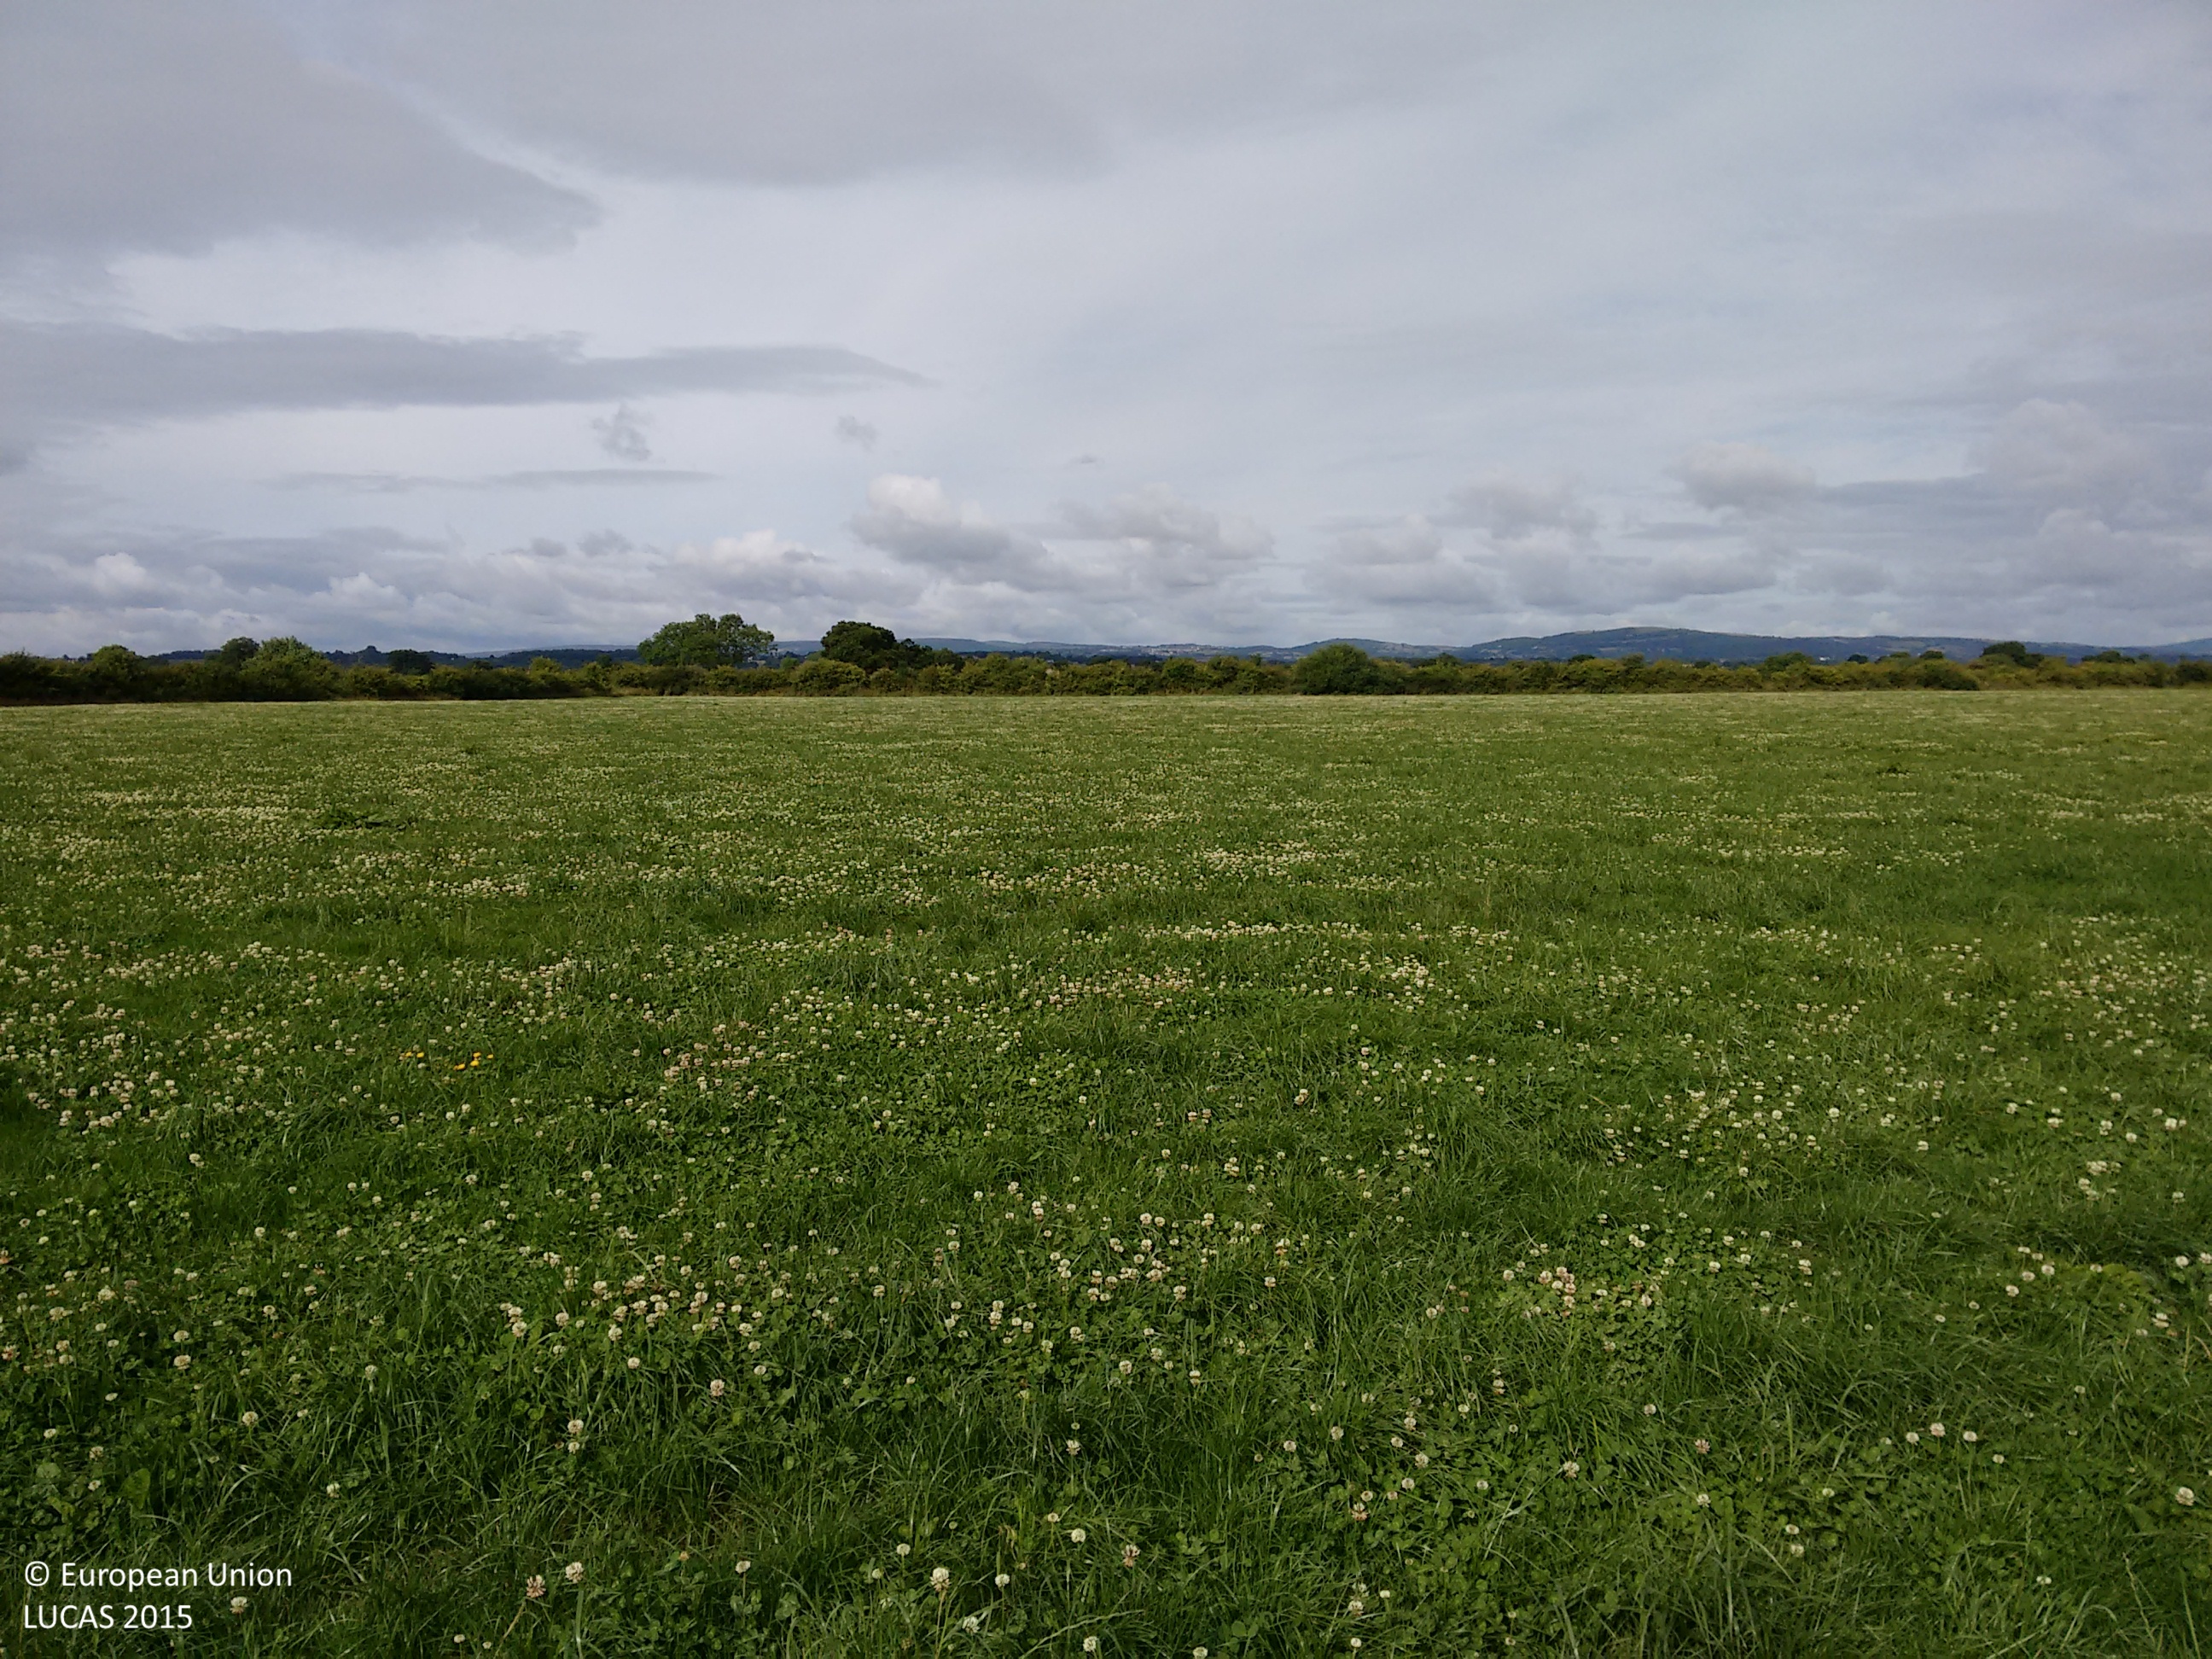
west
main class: Grassland
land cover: Grassland without tree/shrub cover
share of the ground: > 75 %
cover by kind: herbaceous plants 100 %
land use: Agriculture (excluding fallow land and kitchen gardens)
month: July
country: GB
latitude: 53.1085
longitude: -2.9047
